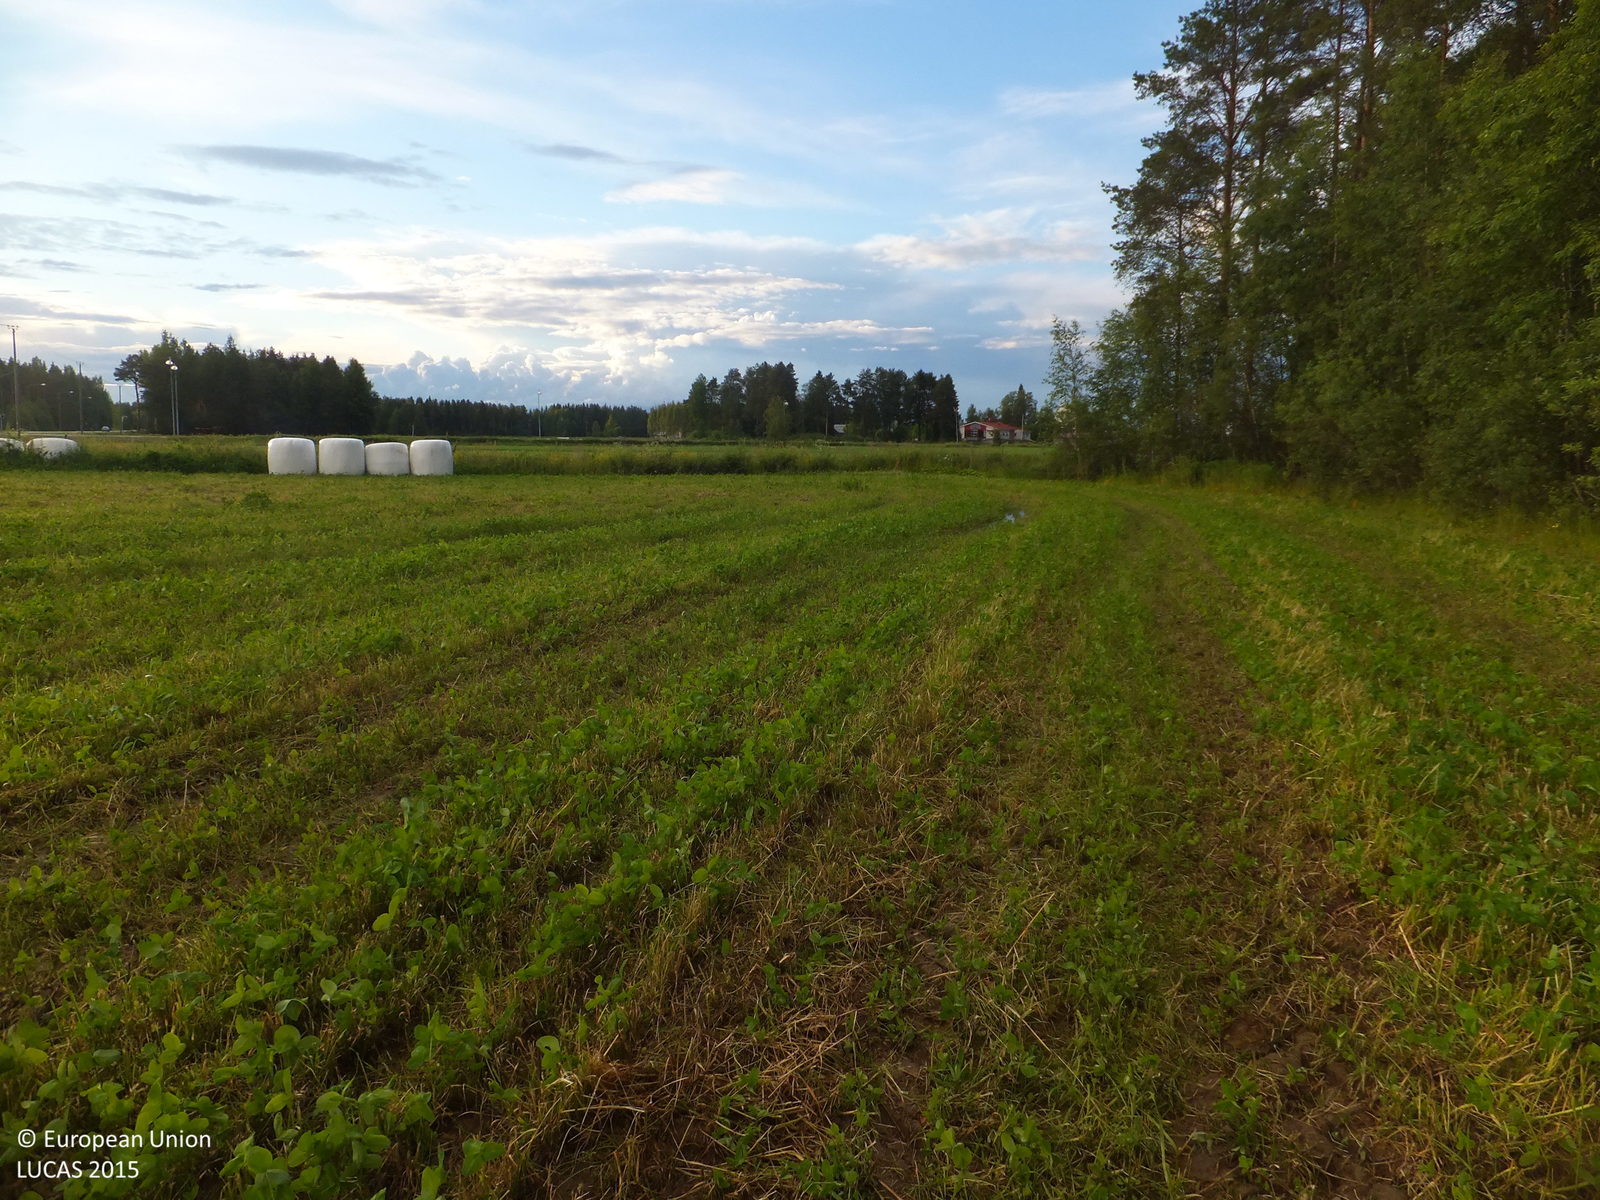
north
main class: Cropland
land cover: Temporary grasslands
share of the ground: 50 - 75 %
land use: Agriculture (excluding fallow land and kitchen gardens)
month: July
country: FI
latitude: 63.0598
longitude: 24.5475
